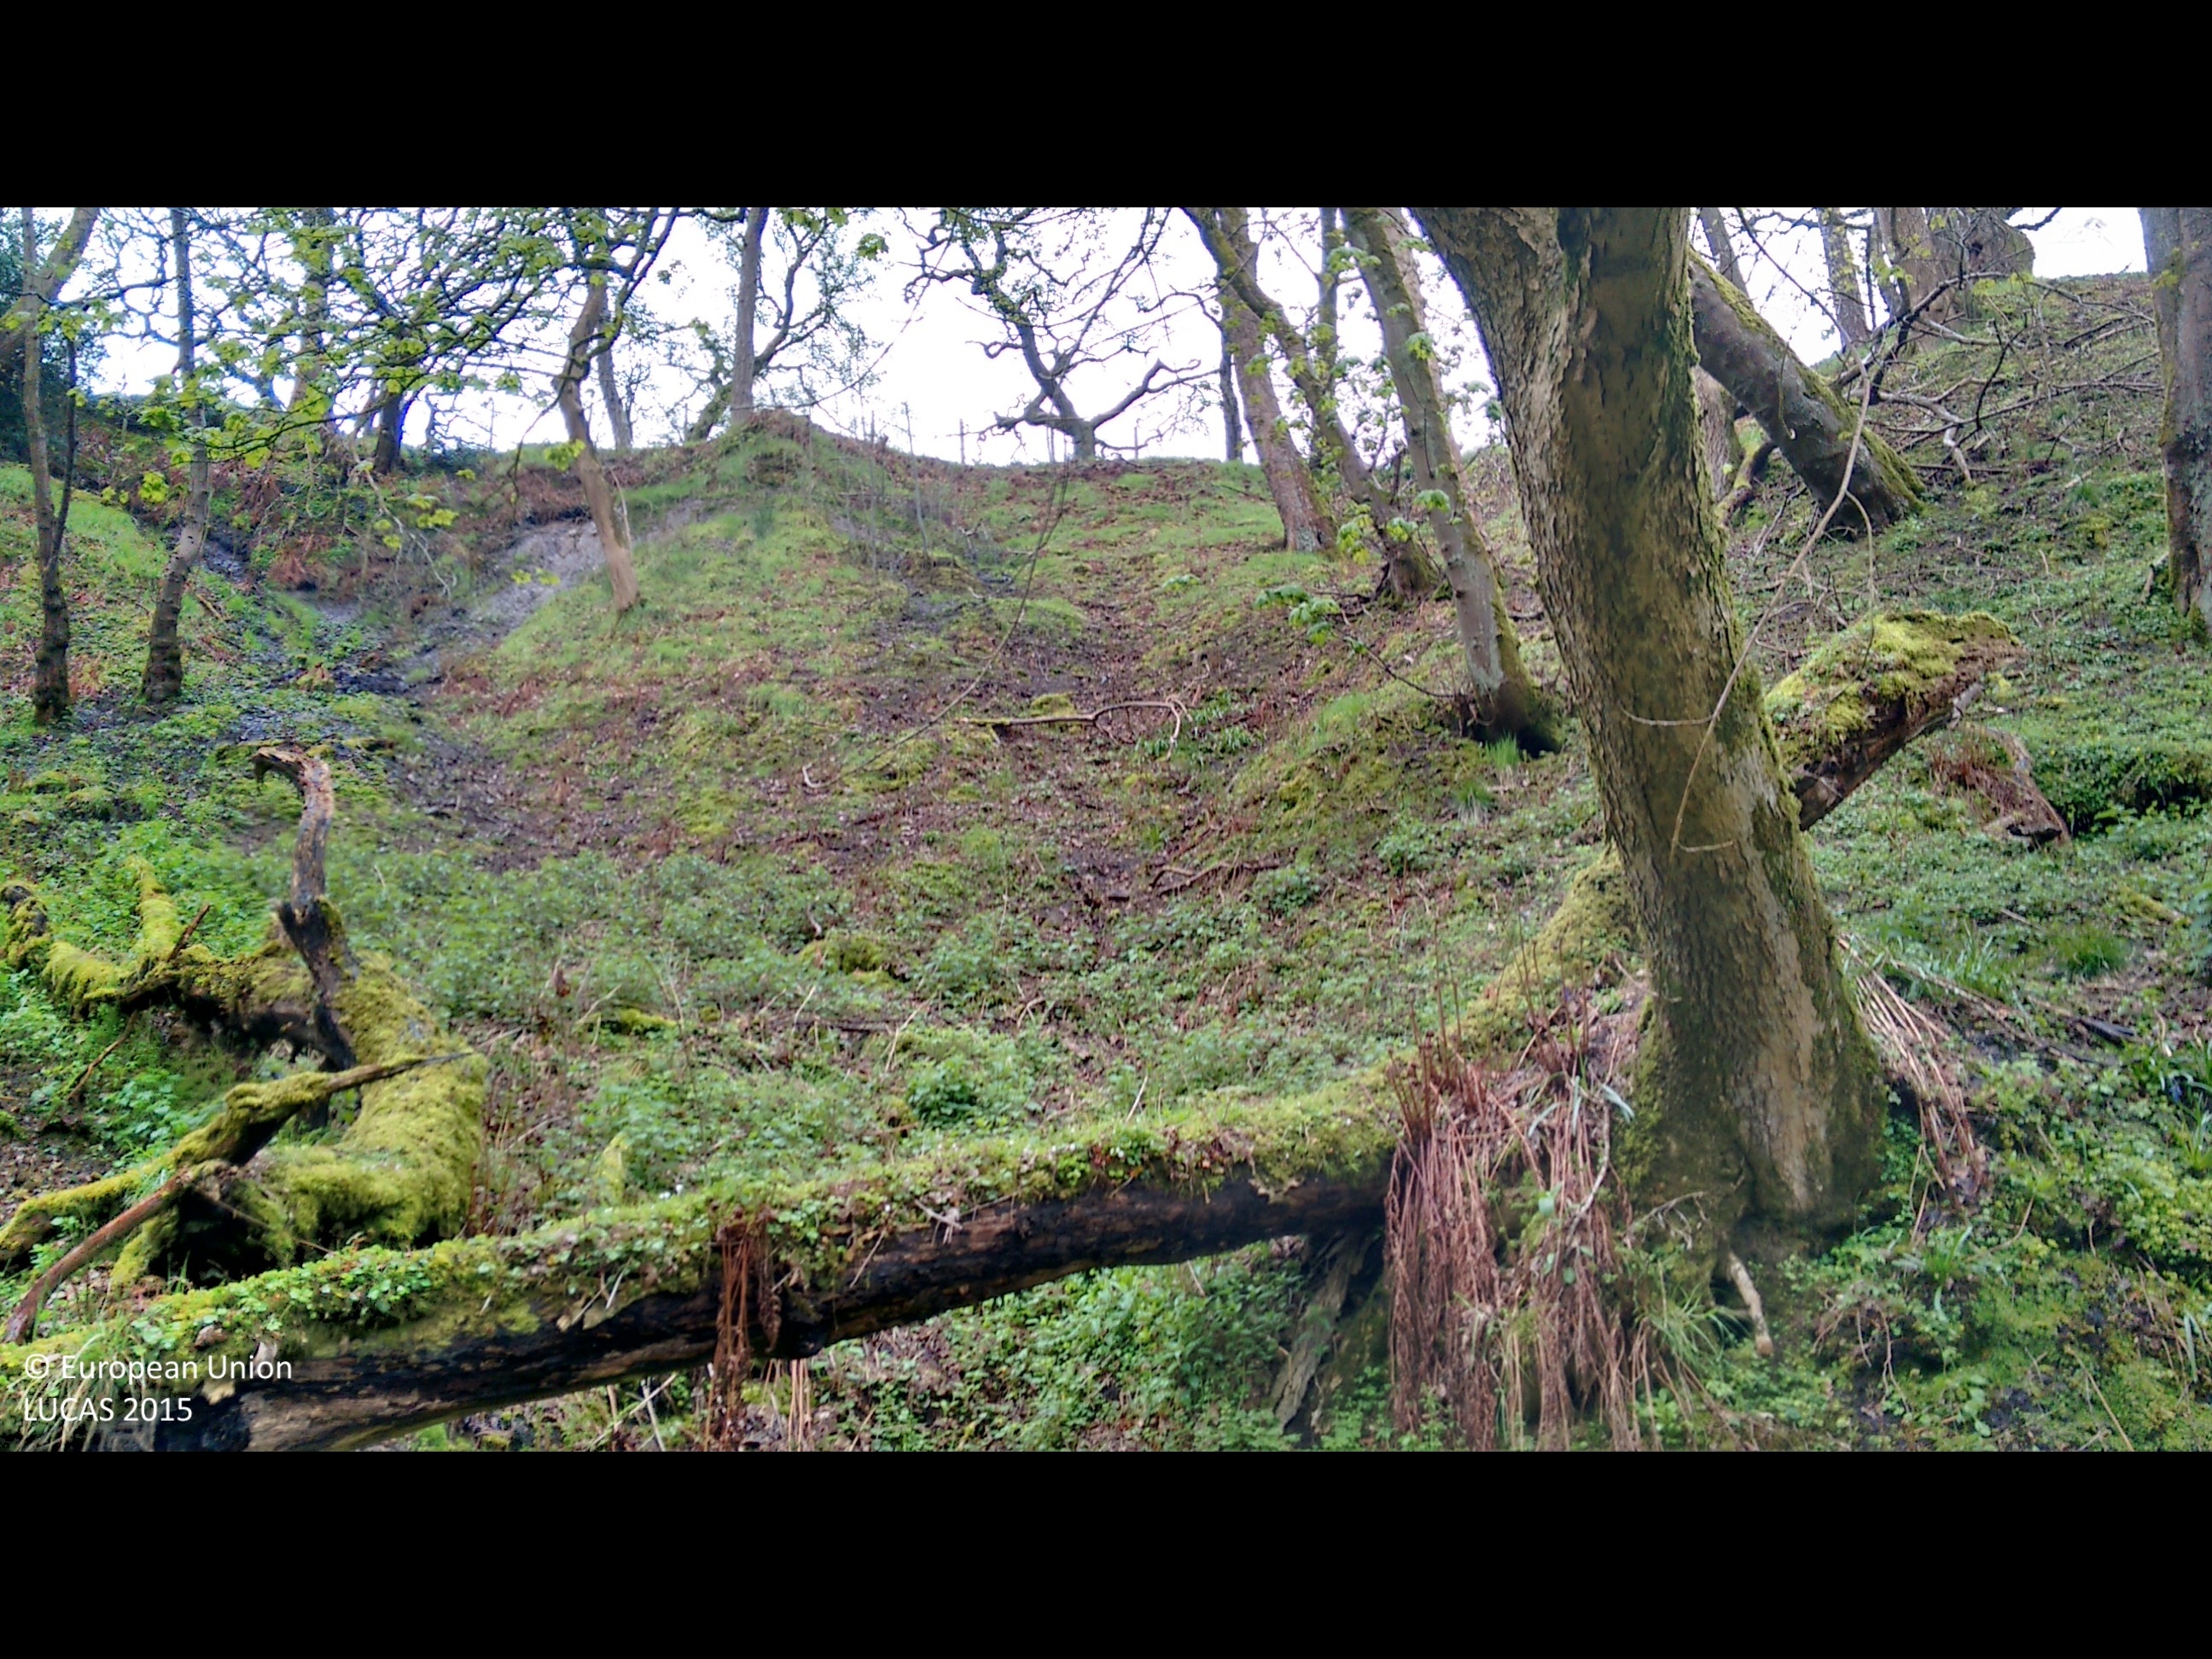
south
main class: Woodland
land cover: Broadleaved woodland
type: mesophytic deciduous forest
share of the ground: > 75 %
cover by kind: broadleaved forest trees 100 %
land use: Amenities, museums, leisure
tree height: > 5 m
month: May
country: GB
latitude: 53.7123
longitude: -2.5353
